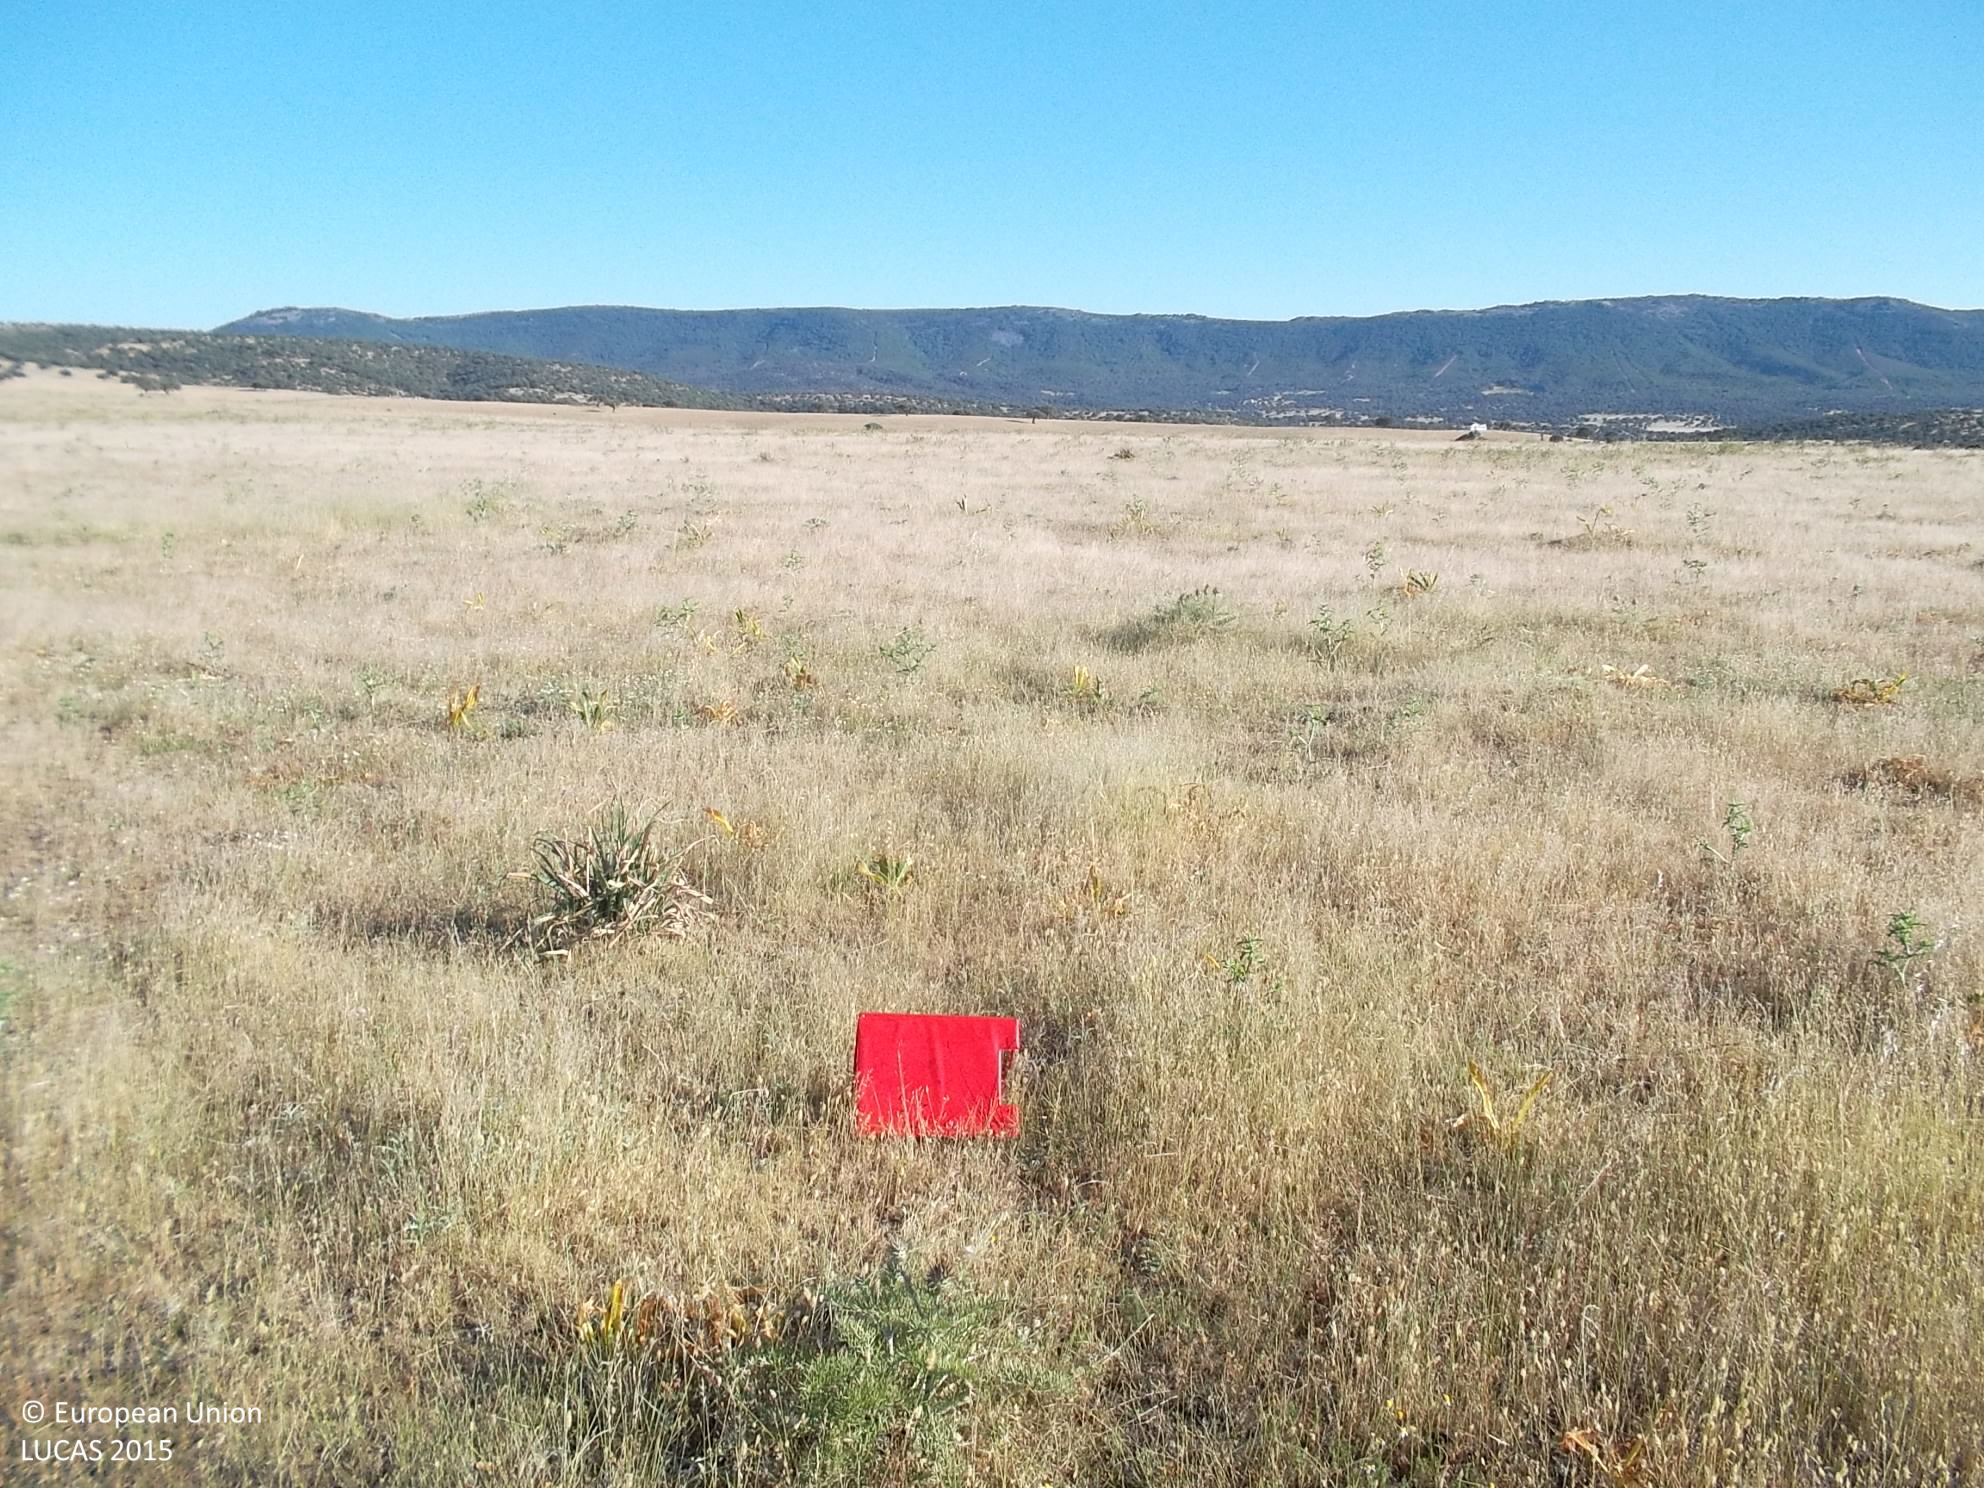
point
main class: Grassland
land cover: Grassland without tree/shrub cover
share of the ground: > 75 %
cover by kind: herbaceous plants 95 %, shrubs 5 %
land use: Agriculture (excluding fallow land and kitchen gardens)
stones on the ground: < 10 %
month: May
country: ES
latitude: 38.6174
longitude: -4.4818
